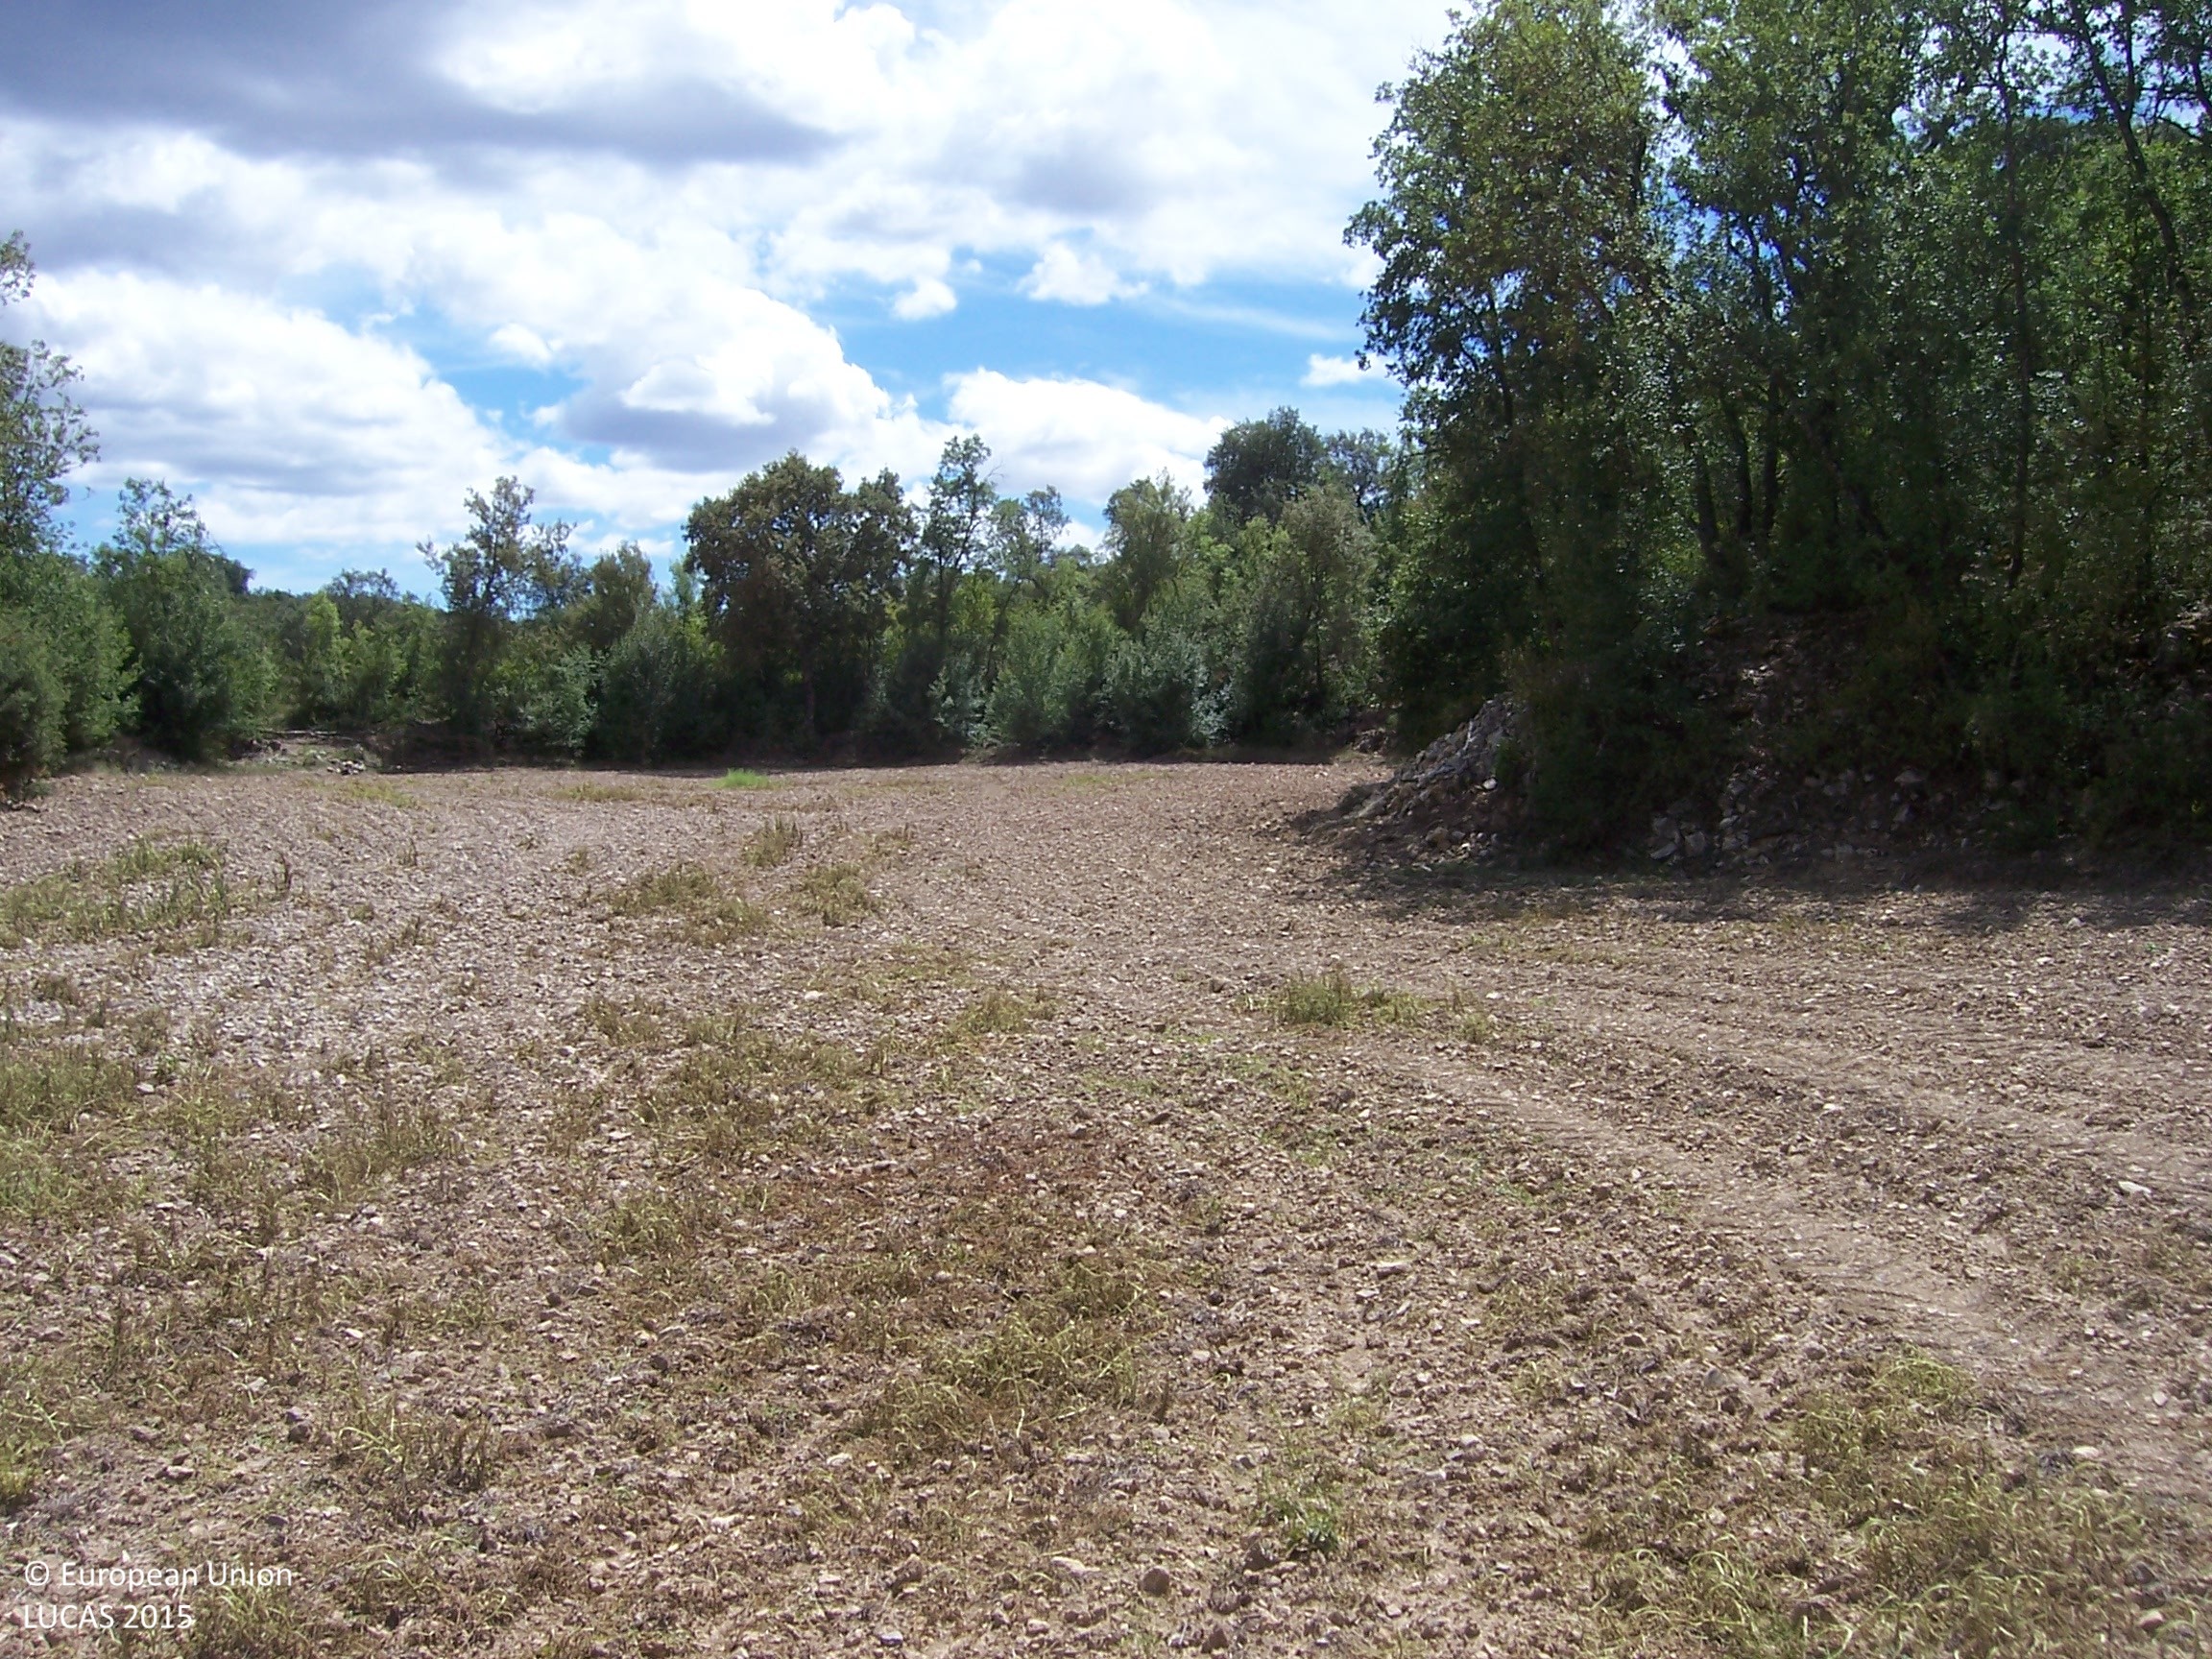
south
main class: Grassland
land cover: Spontaneously vegetated surfaces
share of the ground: > 75 %
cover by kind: unconsolidated bare surface 60 %, herbaceous plants 40 %
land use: Fallow land
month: August
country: ES
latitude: 42.0274
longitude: 0.5270
